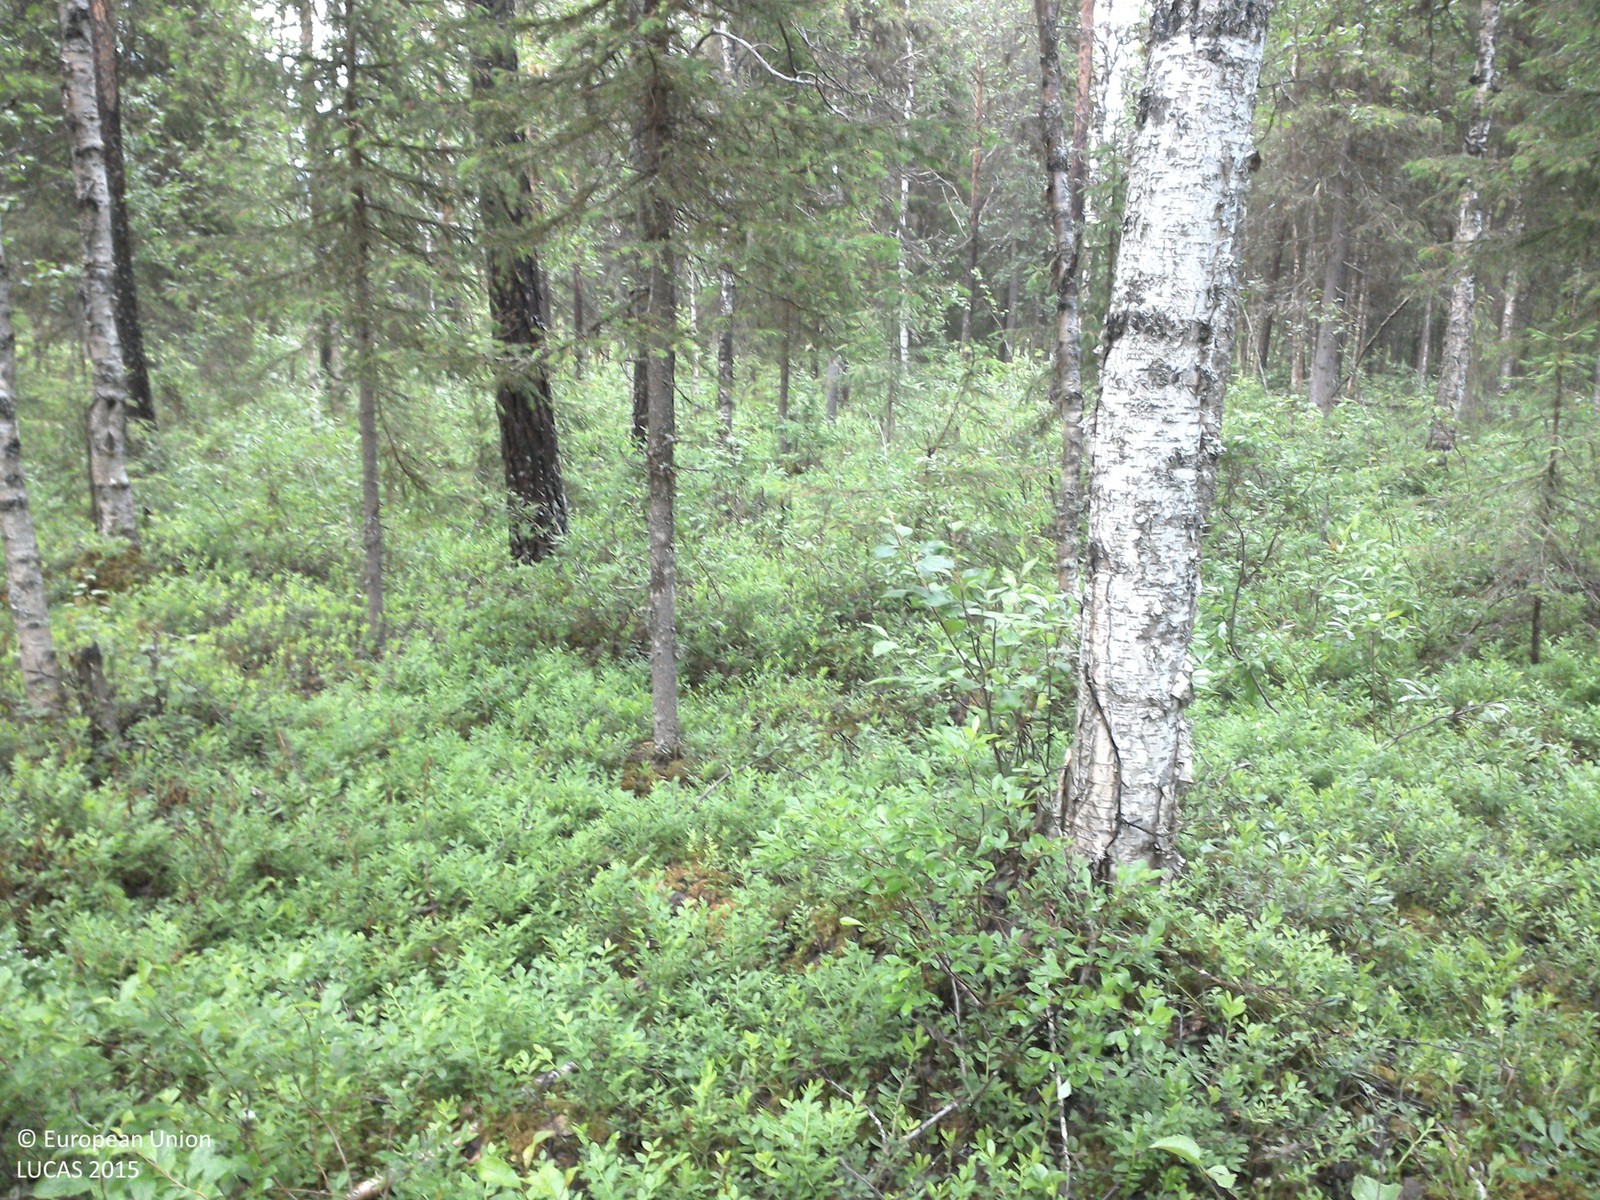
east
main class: Woodland
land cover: Pine dominated mixed woodland
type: boreal forest
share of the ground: 25 - 50 %
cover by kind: shrubs 65 %, coniferous forest trees 20 %, broadleaved forest trees 15 %
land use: Forestry
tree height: > 5 m
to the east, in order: Pine dominated mixed woodland; Spruce dominated mixed woodland; Grassland with sparse tree/shrub cover; Groves; Grass margins; Ditches and canals; Grass margins; Paved roads, cycling and walking lanes; Grass margins; Ditches and canals; Electric lines; Tracks; Ditches and canals; Groves; Spruce dominated mixed woodland; Grassland without tree/shrub cover
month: July
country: SE
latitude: 66.9578
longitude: 23.8335
